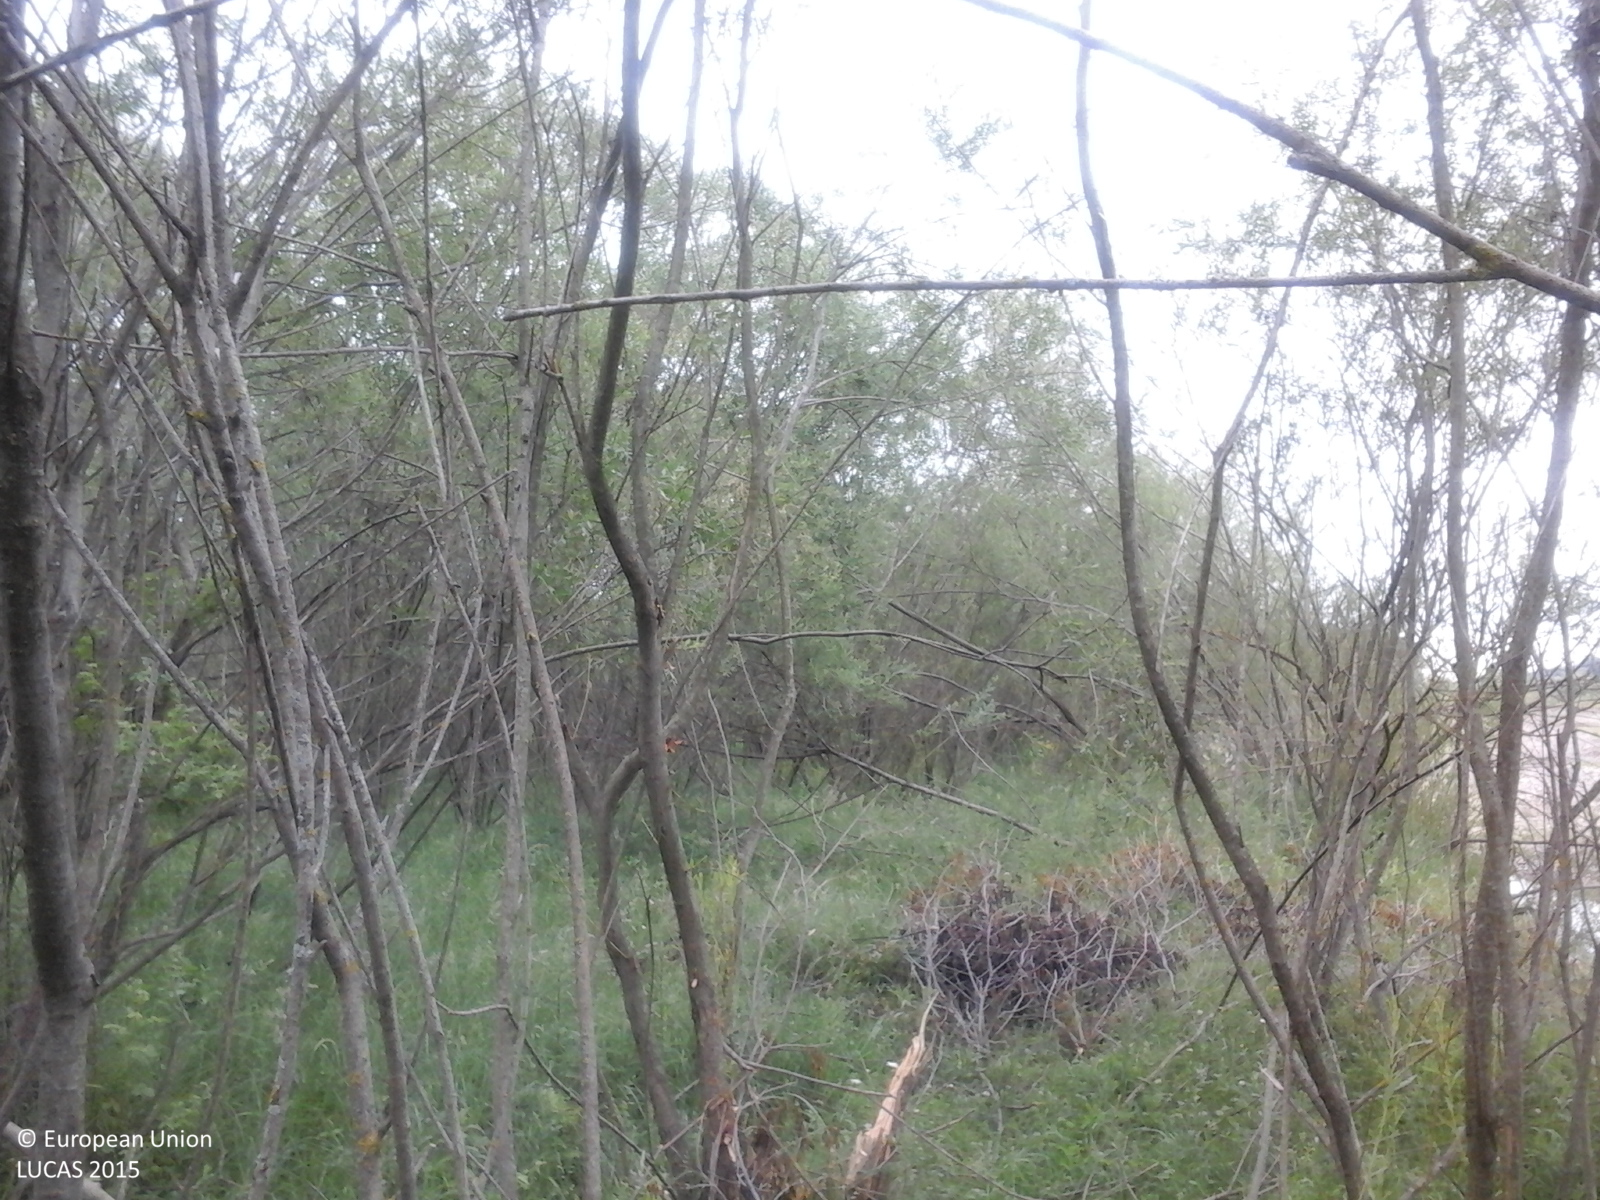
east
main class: Woodland
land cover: Broadleaved woodland
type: thermophilous deciduous forest
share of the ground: > 75 %
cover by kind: broadleaved forest trees 85 %, herbaceous plants 15 %
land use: Semi-natural and natural areas not in use
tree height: > 5 m
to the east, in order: Broadleaved woodland; Tracks; Broadleaved woodland; Tracks; Shrubland with sparse tree cover; Rocks and stones
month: June
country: RO
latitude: 47.9163
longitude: 25.6856
